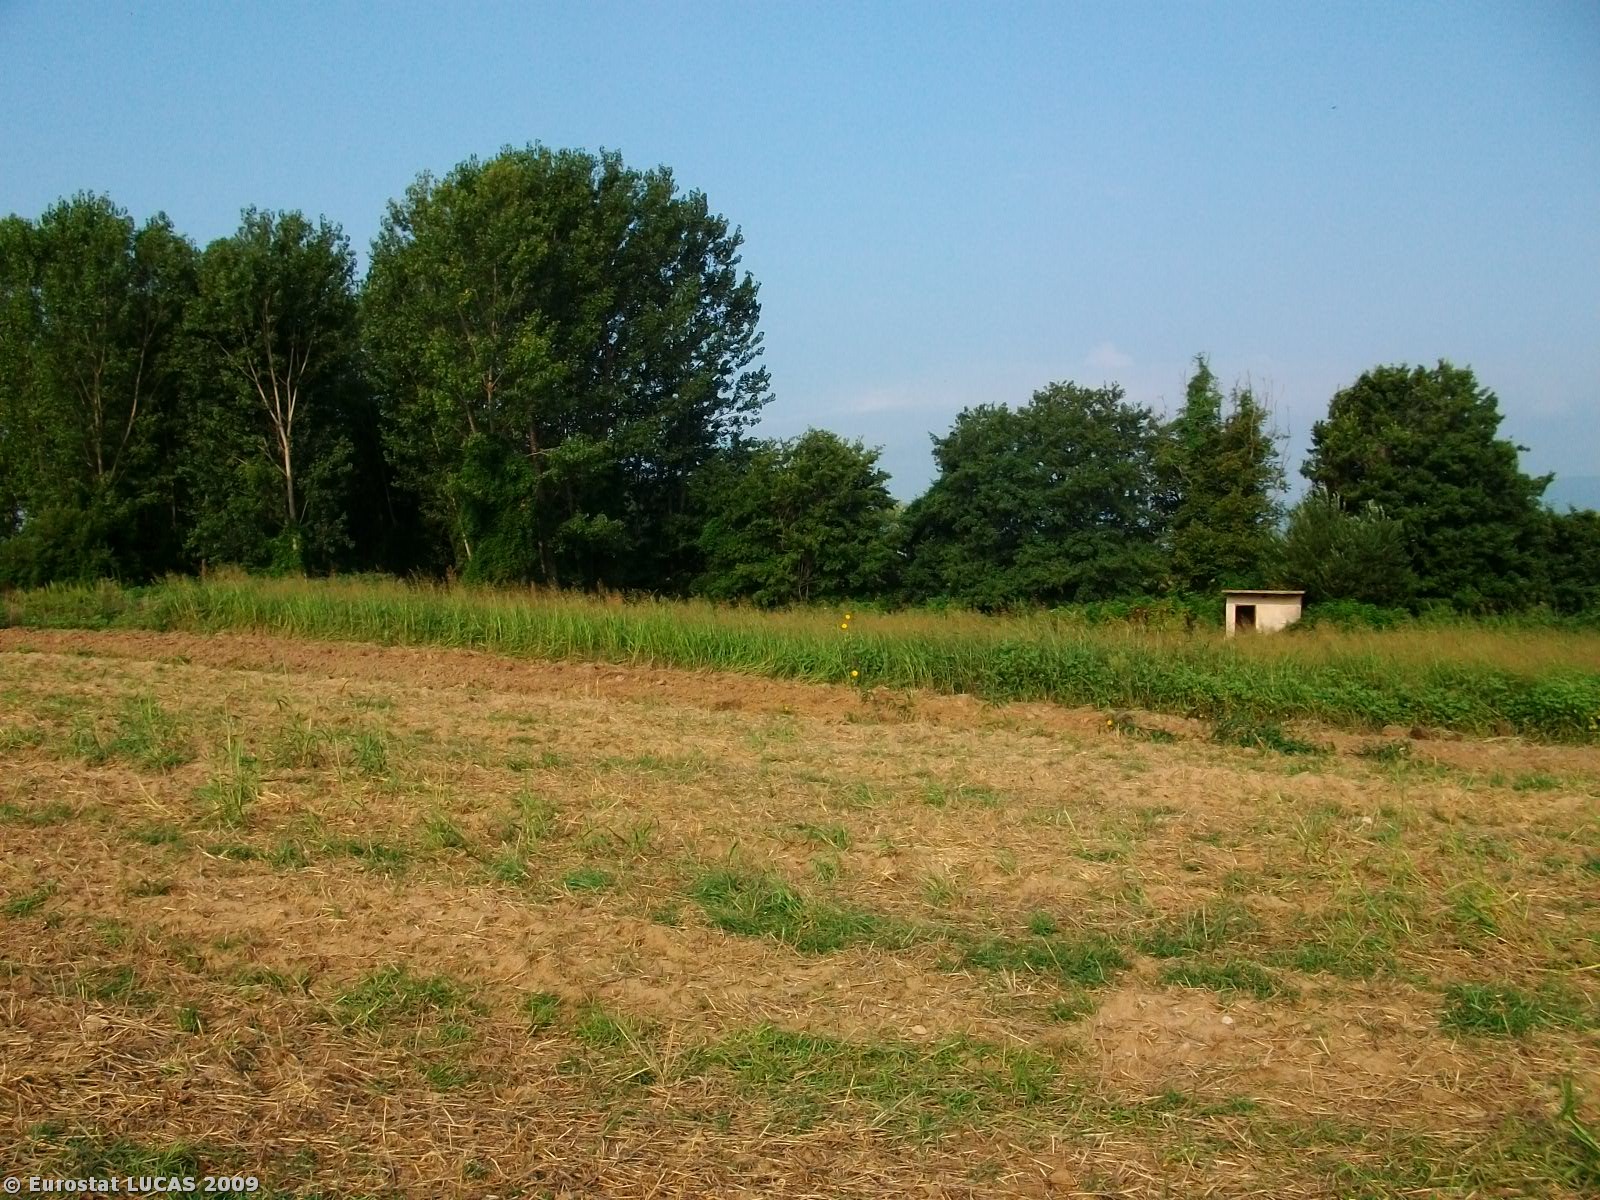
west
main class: Grassland
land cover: Grassland without tree/shrub cover
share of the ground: > 75 %
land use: Agriculture (excluding fallow land and kitchen gardens)
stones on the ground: < 10 %
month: September
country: GR
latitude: 41.2483
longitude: 22.8412
